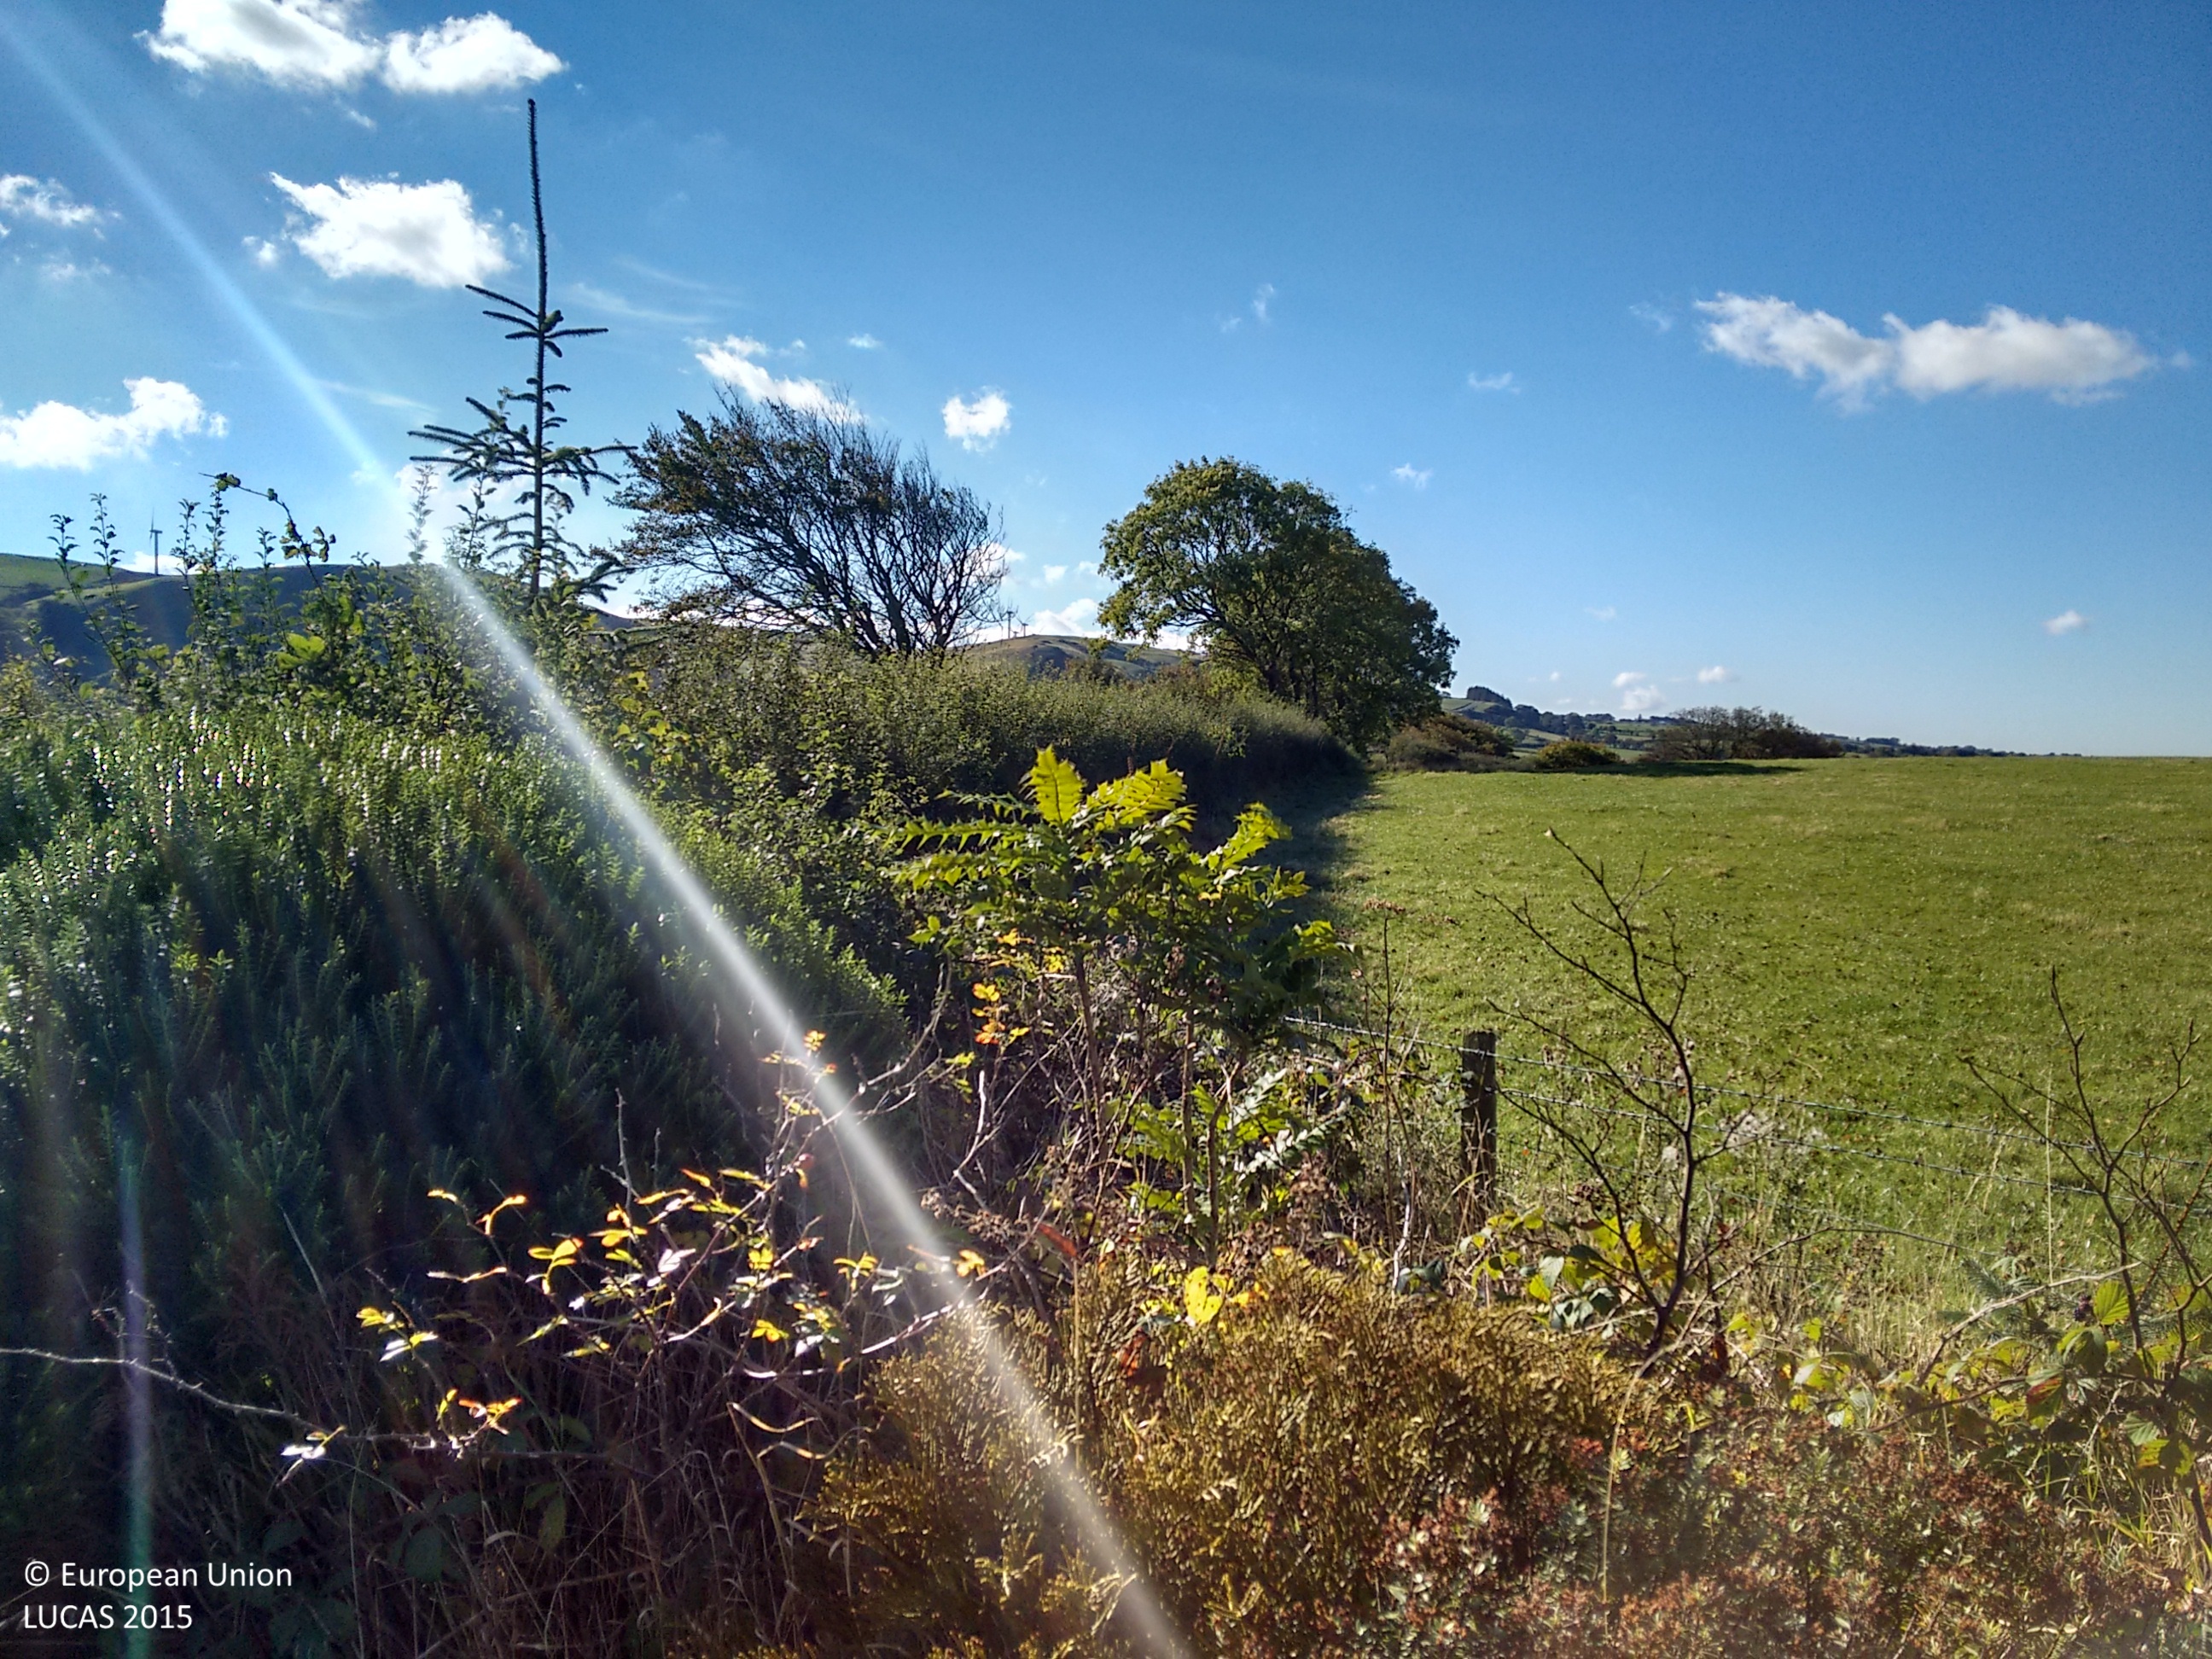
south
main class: Grassland
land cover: Grassland without tree/shrub cover
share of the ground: > 75 %
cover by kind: herbaceous plants 100 %
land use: Agriculture (excluding fallow land and kitchen gardens)
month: October
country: GB
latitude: 52.3252
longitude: -4.0192
